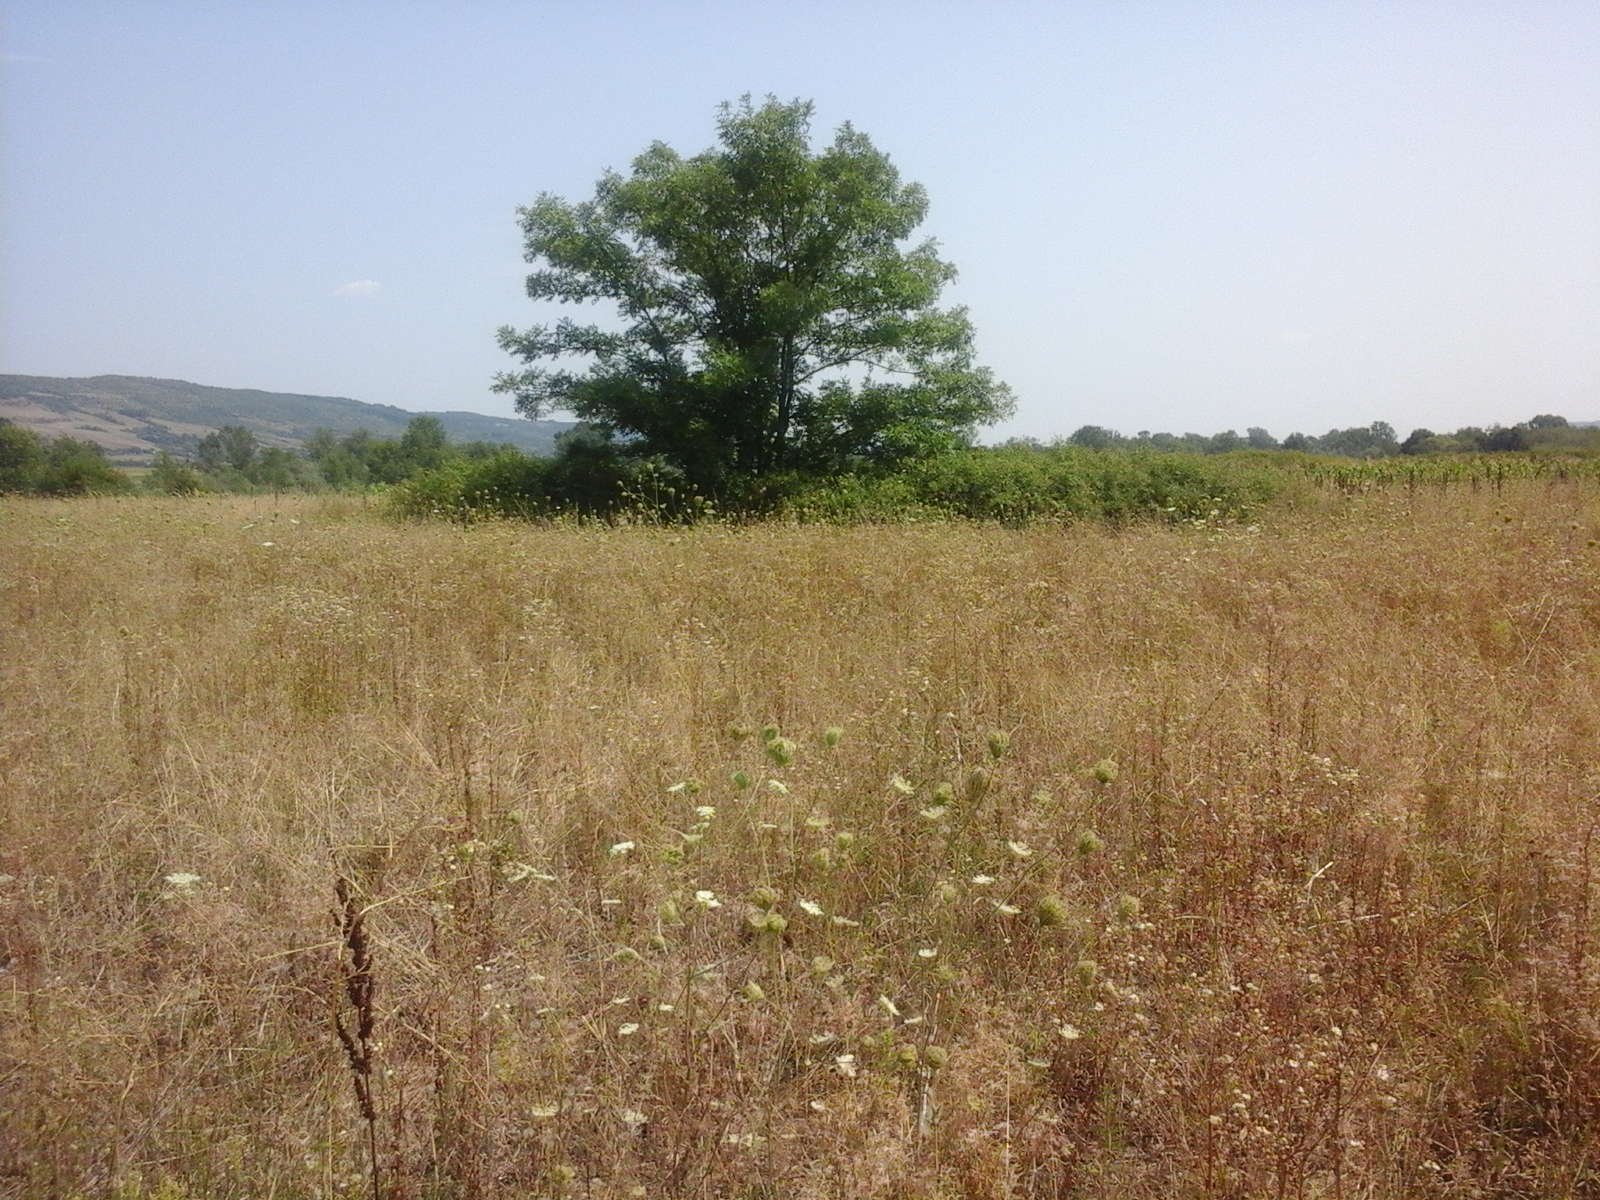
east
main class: Grassland
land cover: Spontaneously vegetated surfaces
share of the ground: > 75 %
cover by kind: herbaceous plants 100 %
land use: Agriculture (excluding fallow land and kitchen gardens)
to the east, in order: Spontaneously vegetated surfaces; Single bushes/trees; Spontaneously vegetated surfaces; Common wheat; Spontaneously vegetated surfaces; Common wheat; Maize; Common wheat; Spontaneously vegetated surfaces; Maize; Spontaneously vegetated surfaces; Maize; Grass margins; Tracks; Grassland without tree/shrub cover
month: August
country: RO
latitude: 44.5838
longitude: 23.3136
